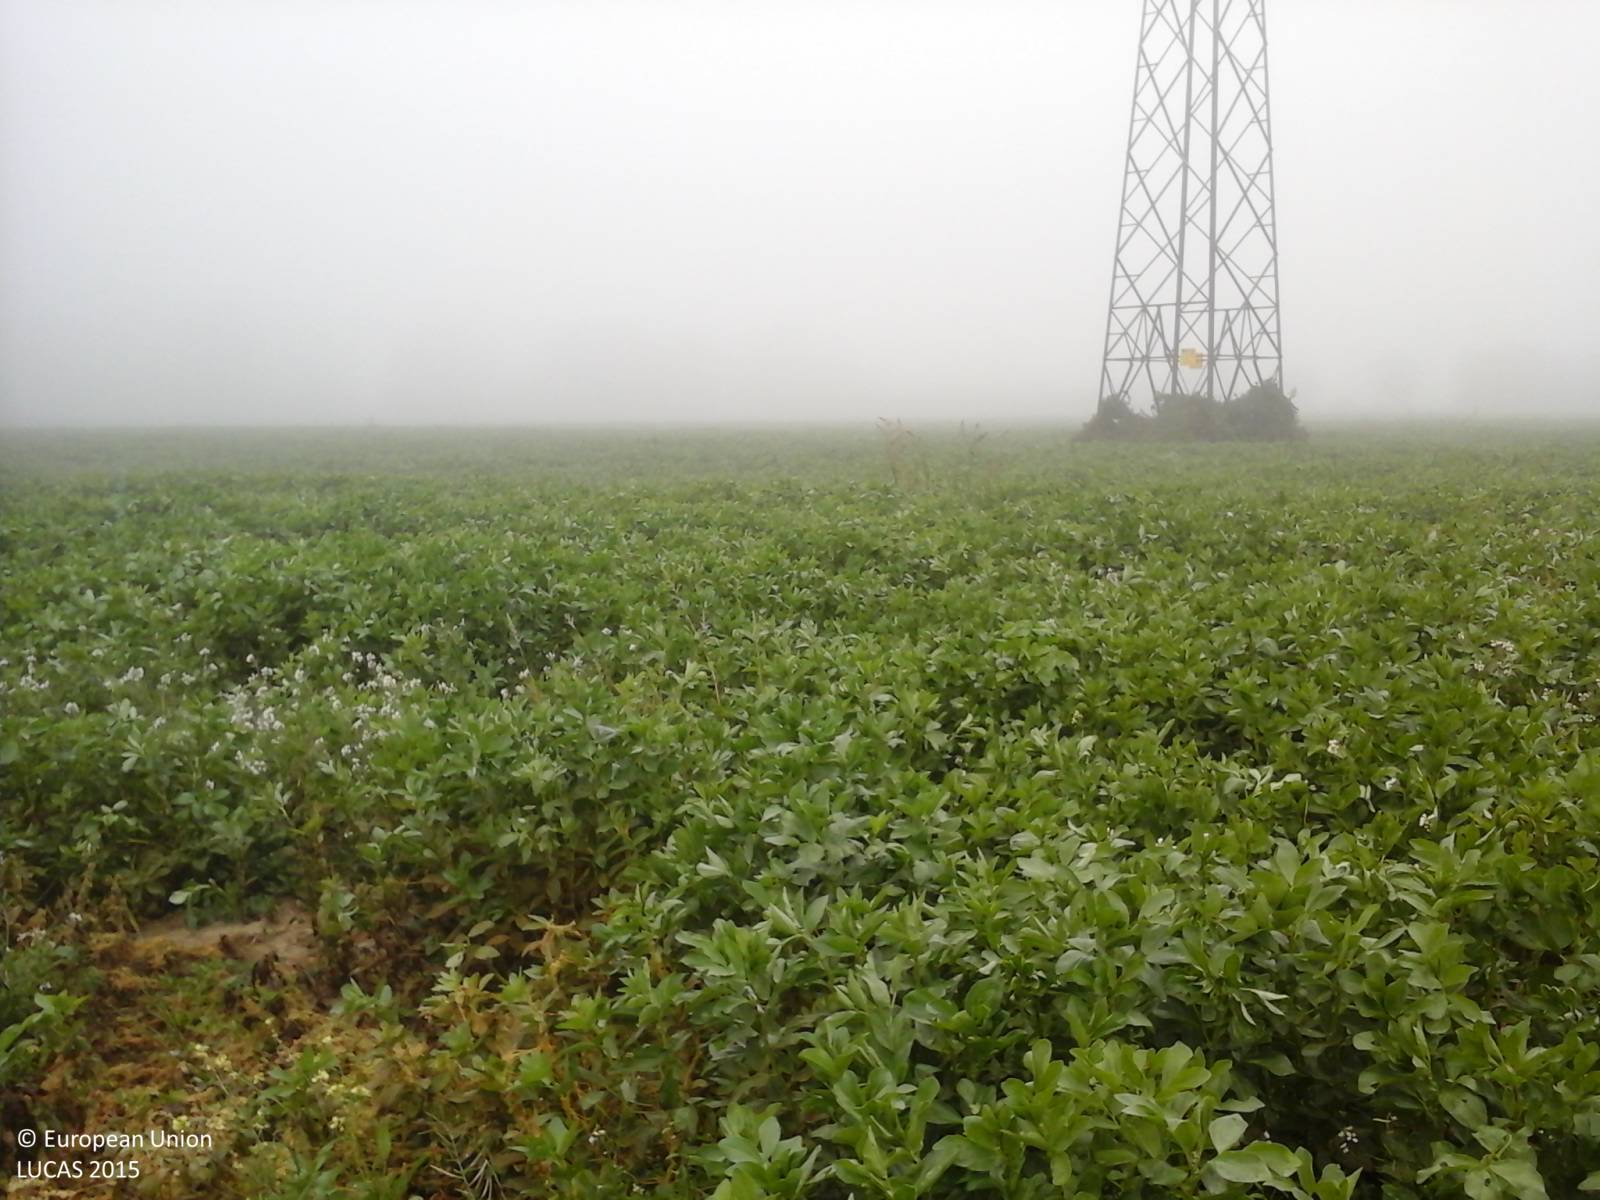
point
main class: Cropland
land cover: Other leguminous and mixtures for fodder
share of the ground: > 75 %
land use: Agriculture (excluding fallow land and kitchen gardens)
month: October
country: IT
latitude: 42.8062
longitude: 12.4016
